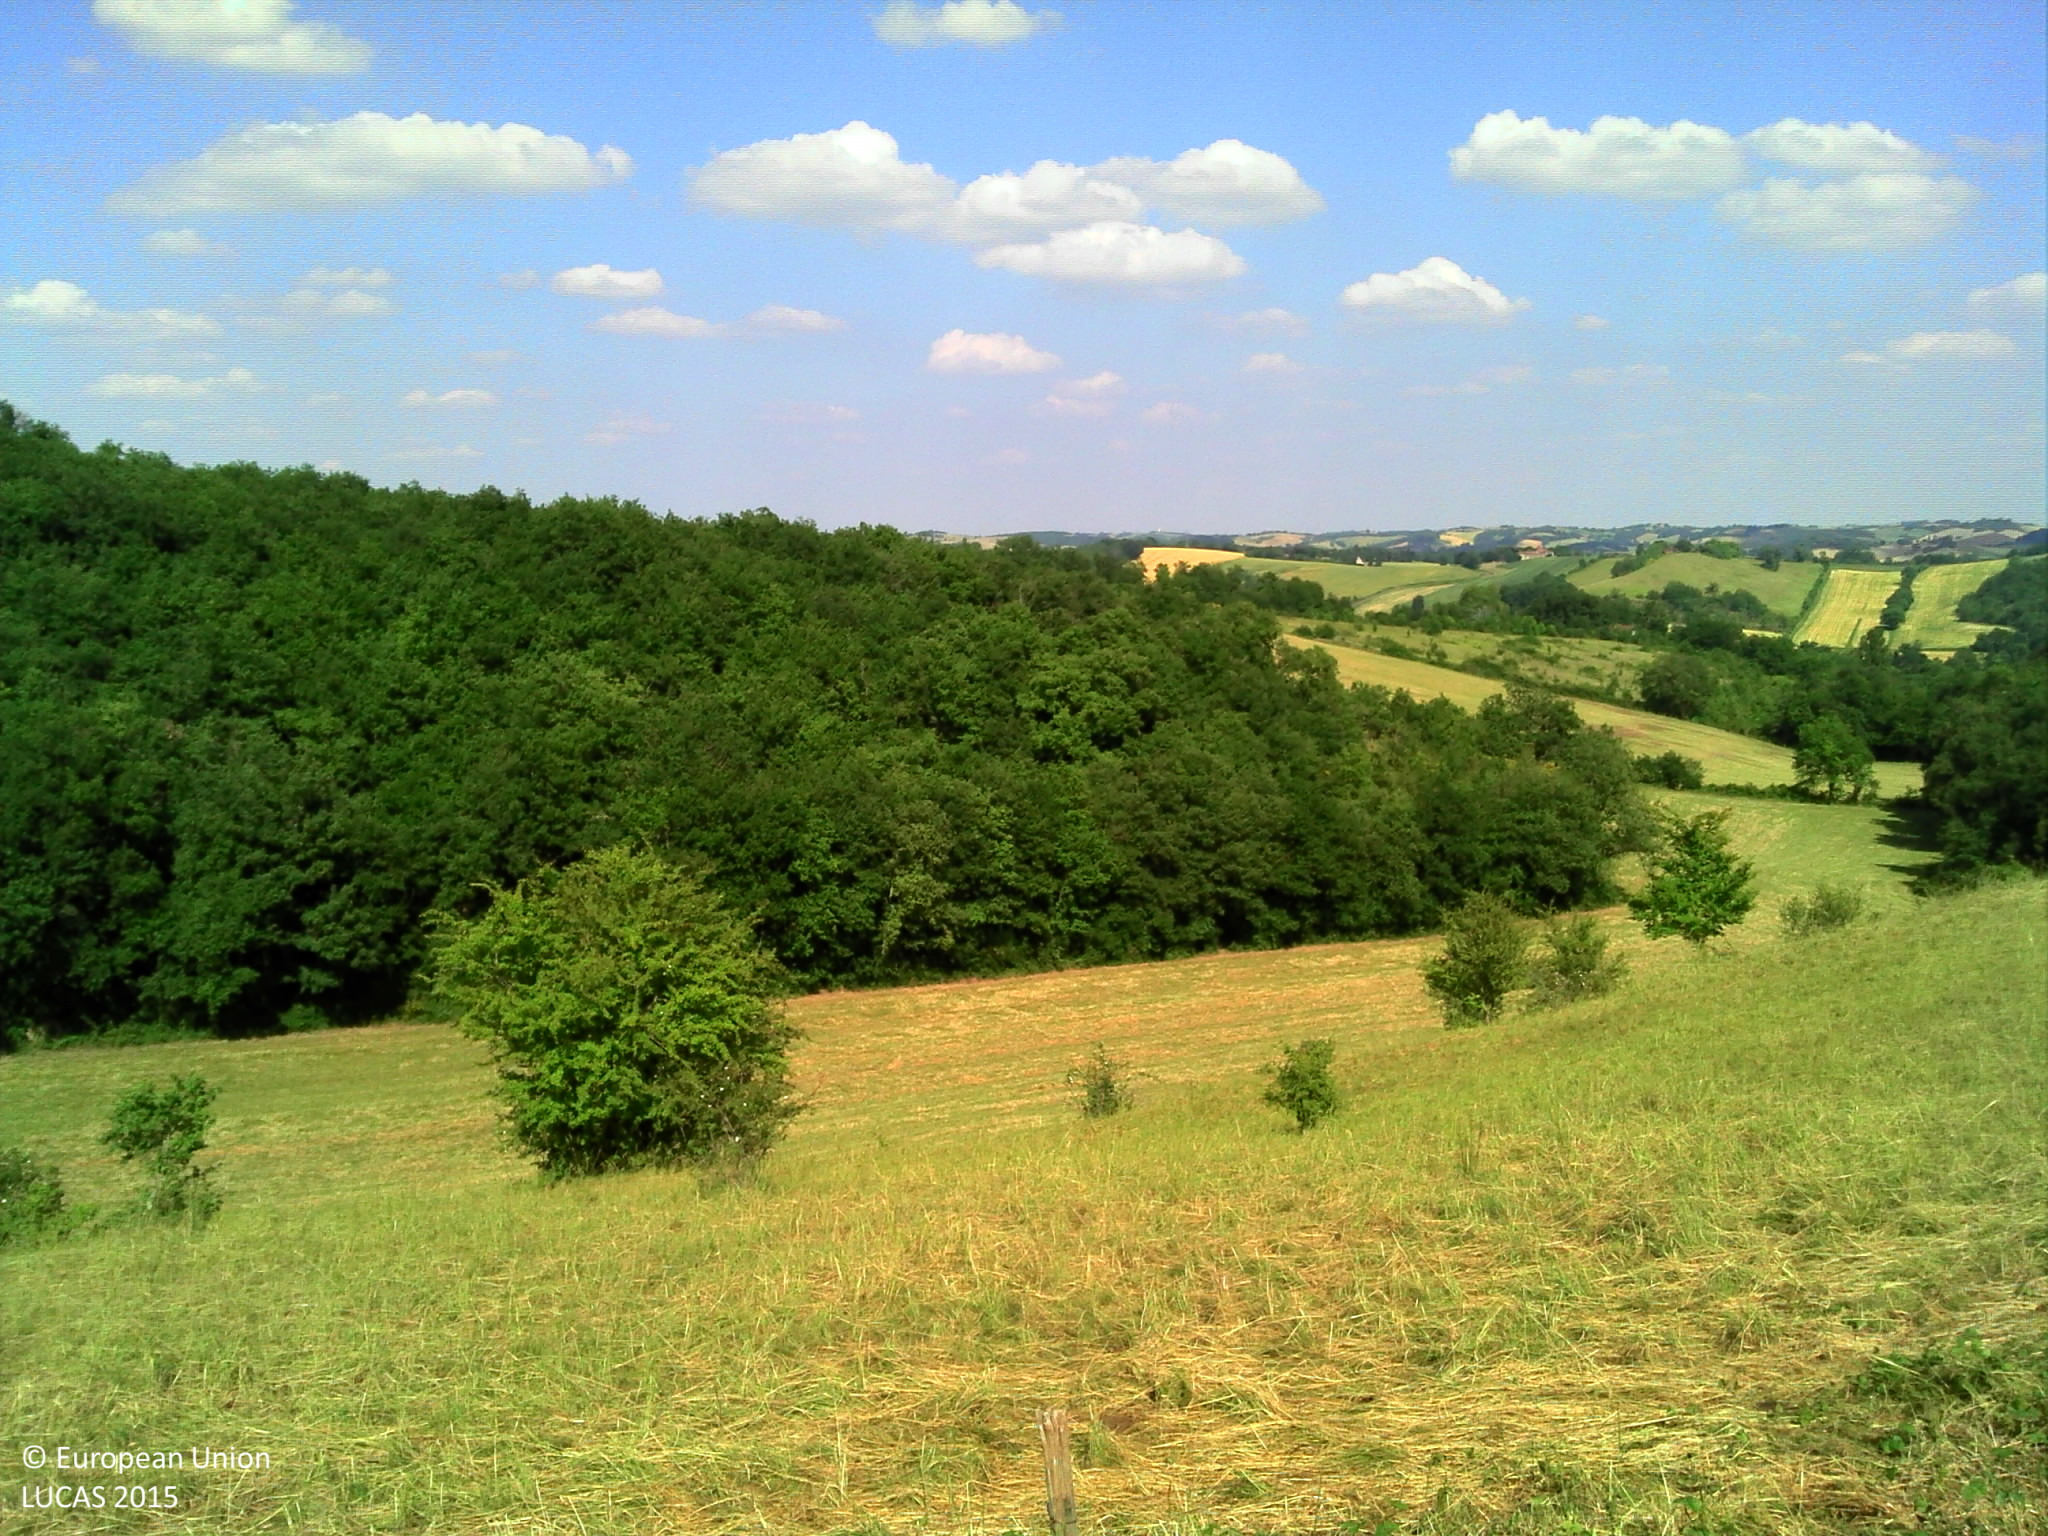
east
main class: Cropland
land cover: Temporary grasslands
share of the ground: > 75 %
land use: Agriculture (excluding fallow land and kitchen gardens)
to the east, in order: Temporary grasslands; Grass margins; Fences; Grassland with sparse tree/shrub cover; Tracks; Grassland with sparse tree/shrub cover; Grassland without tree/shrub cover; Broadleaved woodland; Fences; Broadleaved woodland
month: June
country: FR
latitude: 43.4976
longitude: 0.7117
